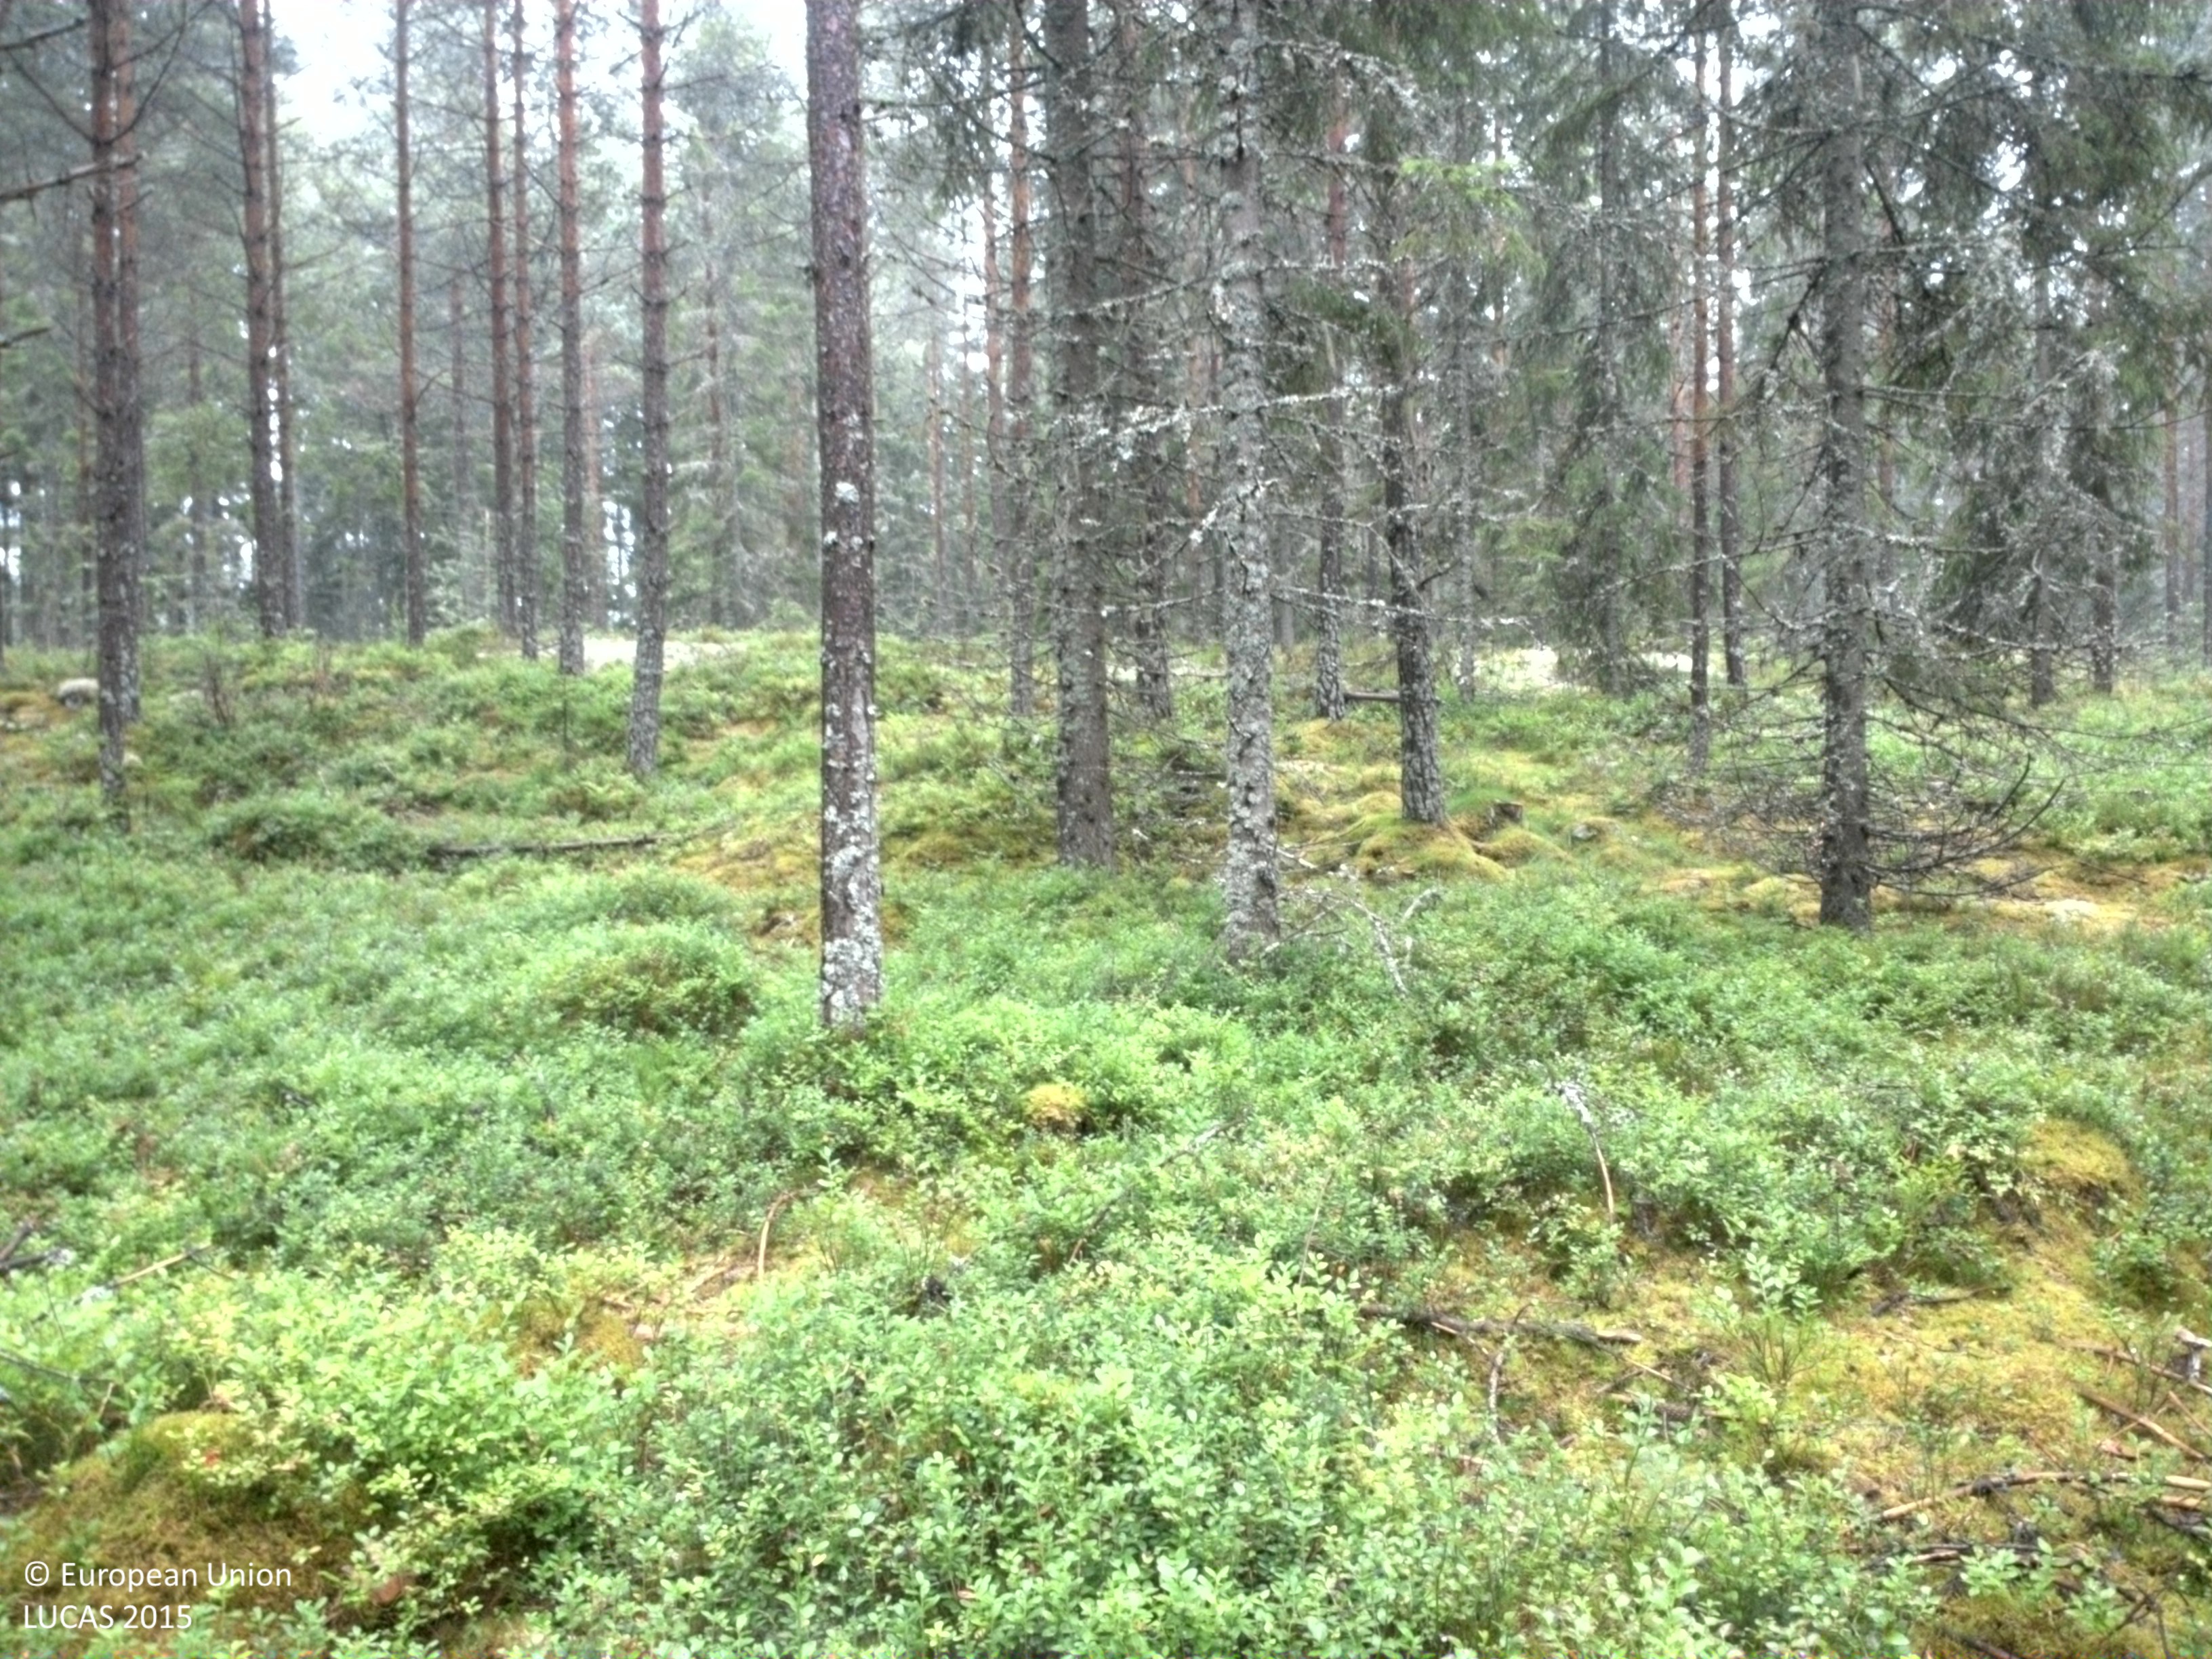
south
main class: Woodland
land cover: Pine dominated coniferous woodland
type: boreal forest
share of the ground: 50 - 75 %
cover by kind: coniferous forest trees 65 %, shrubs 20 %, lichens and mosses 10 %, broadleaved forest trees 5 %
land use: Forestry
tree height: > 5 m
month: August
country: SE
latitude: 59.4430
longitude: 13.1491
